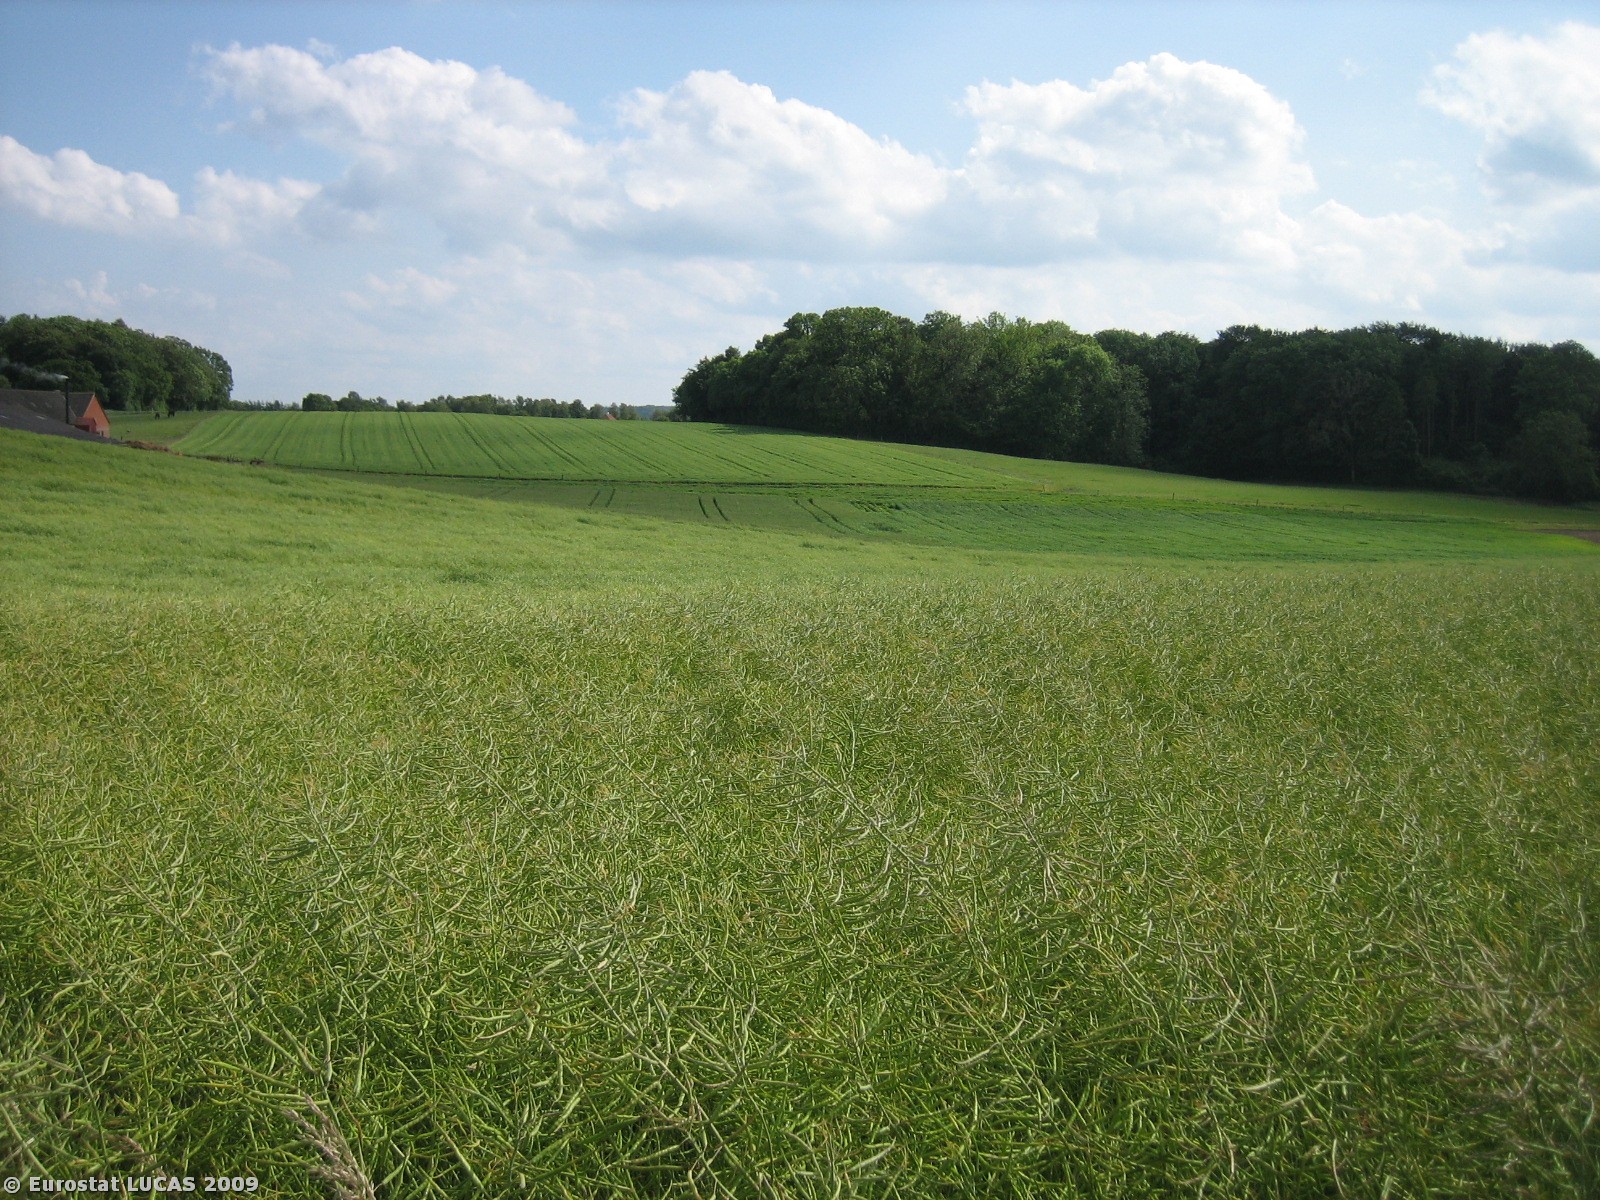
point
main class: Cropland
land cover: Rape and turnip rape
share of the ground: > 75 %
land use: Agriculture (excluding fallow land and kitchen gardens)
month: June
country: DK
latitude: 55.7563
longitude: 9.9841
